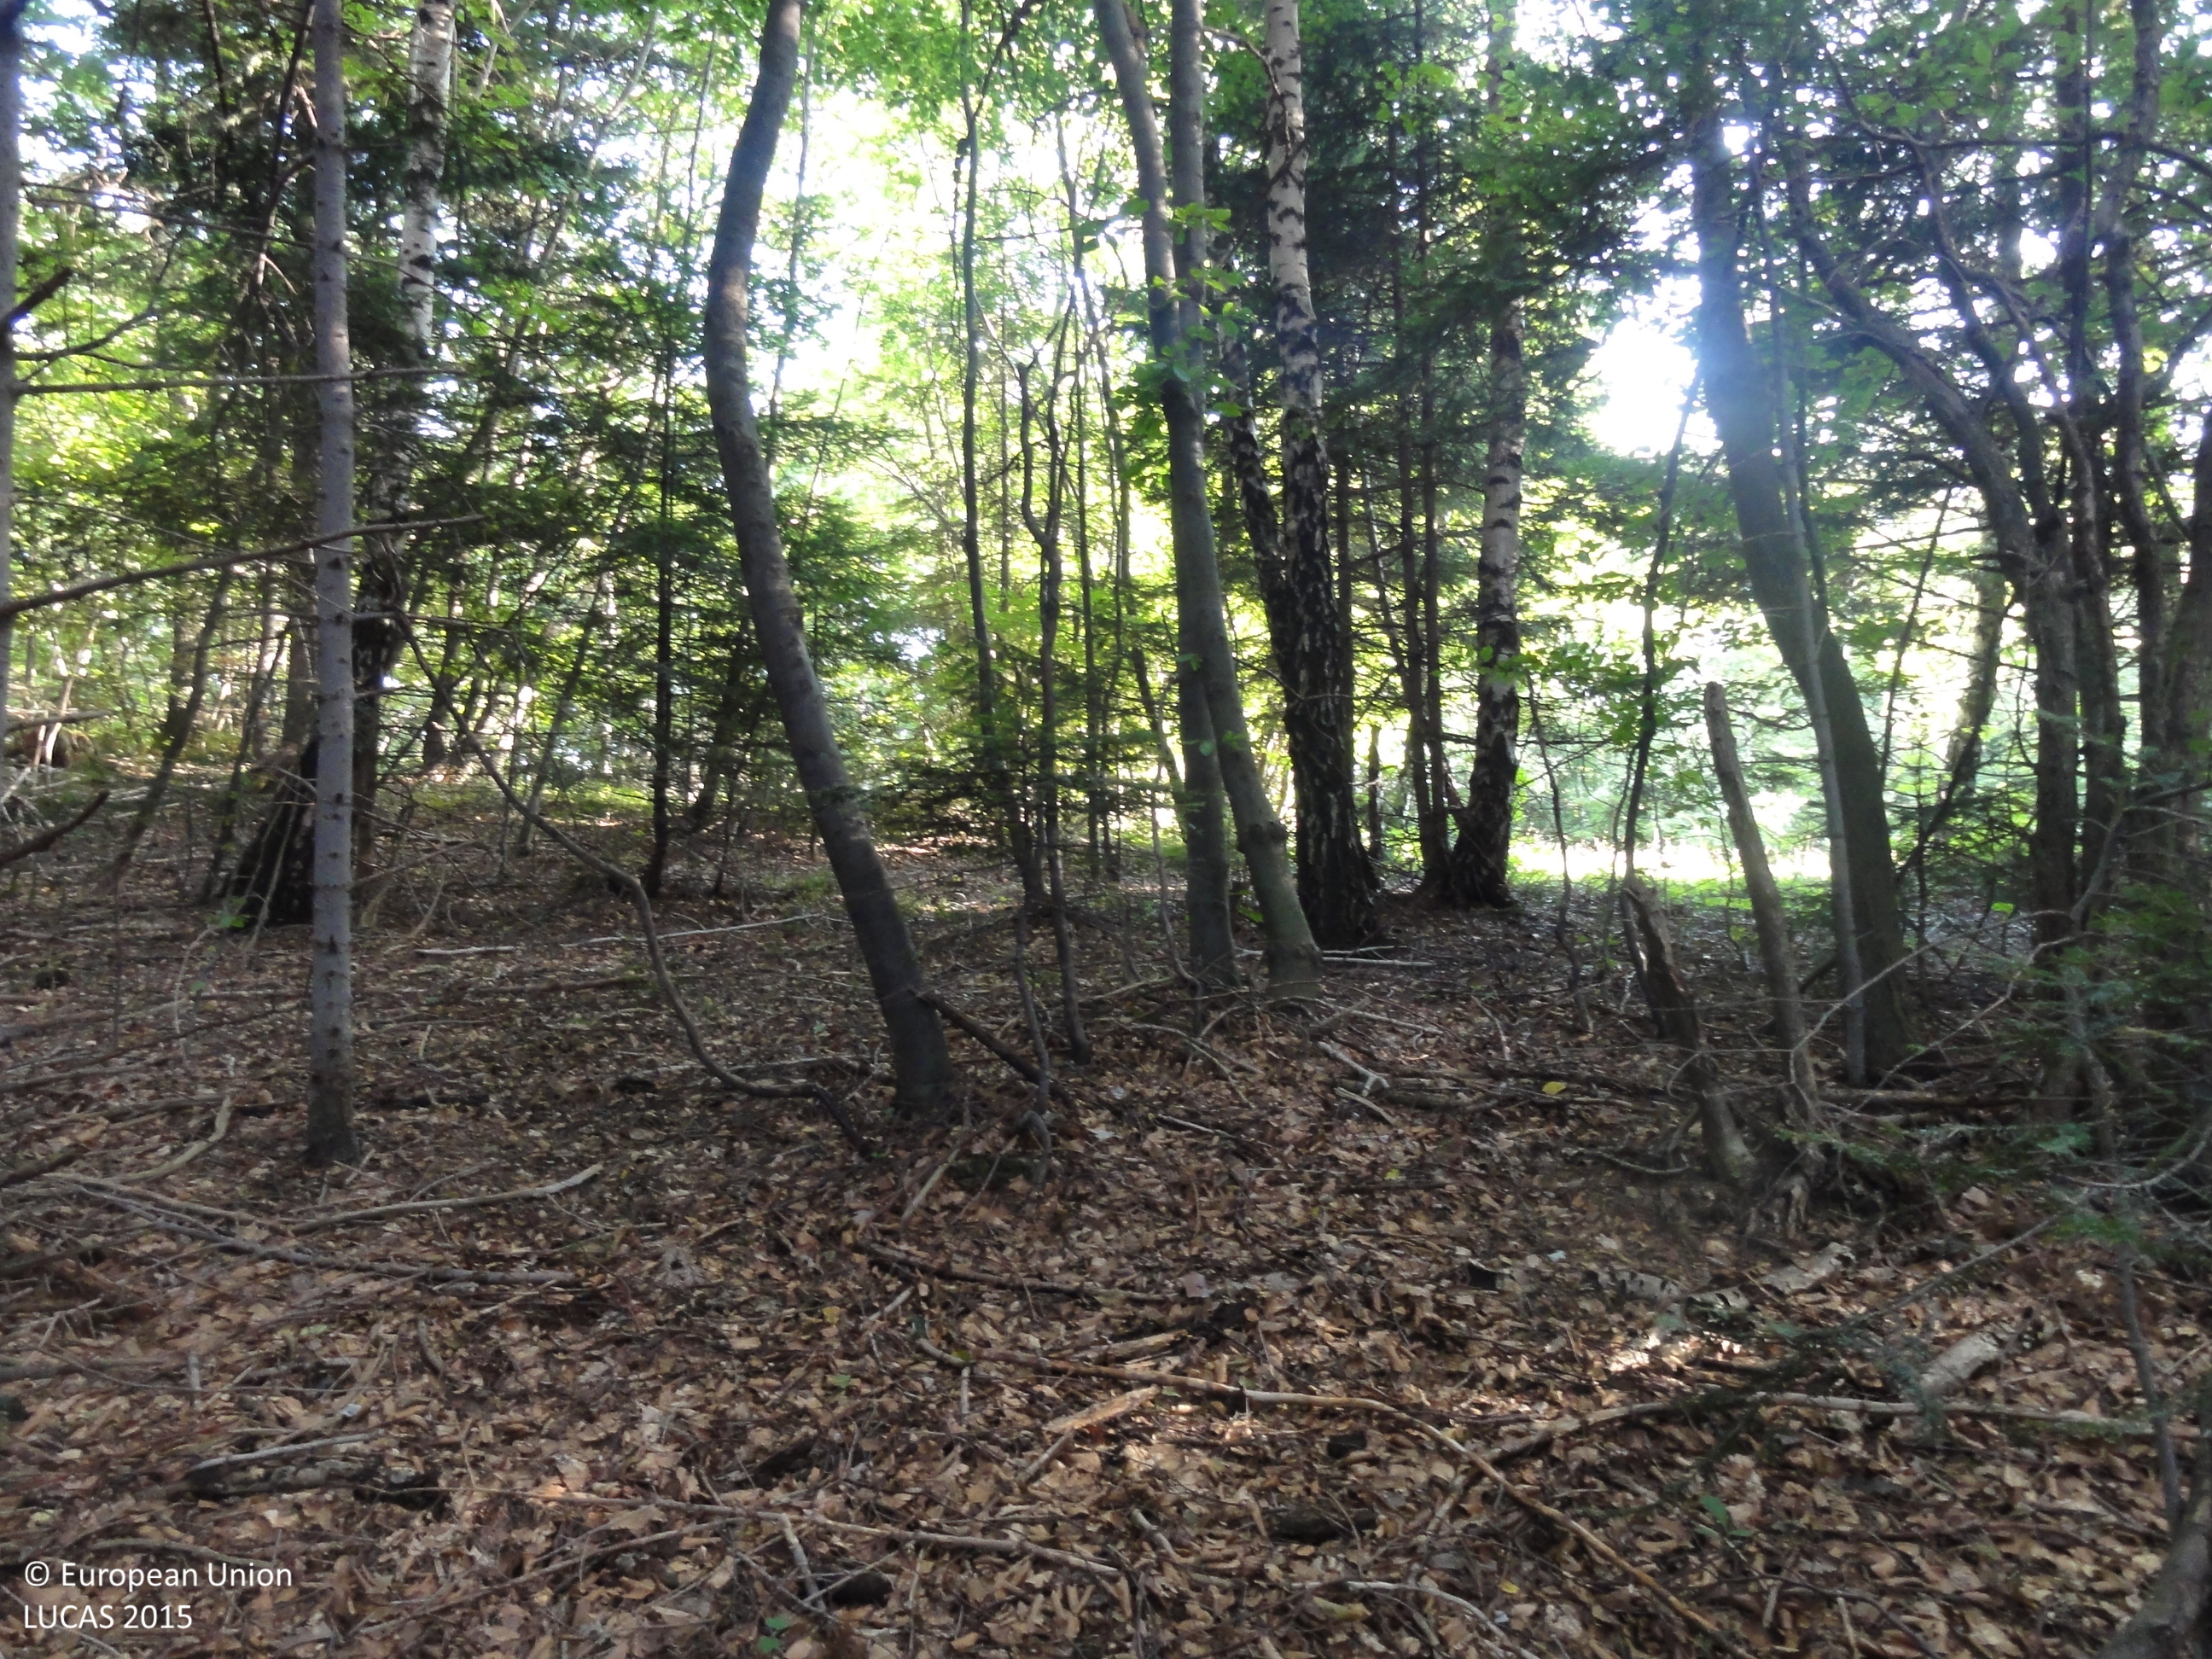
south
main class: Woodland
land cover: Spruce dominated mixed woodland
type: mountainous beech forest
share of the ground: > 75 %
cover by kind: coniferous forest trees 70 %, broadleaved forest trees 30 %
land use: Forestry
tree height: > 5 m
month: August
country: SI
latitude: 46.0657
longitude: 15.4919
